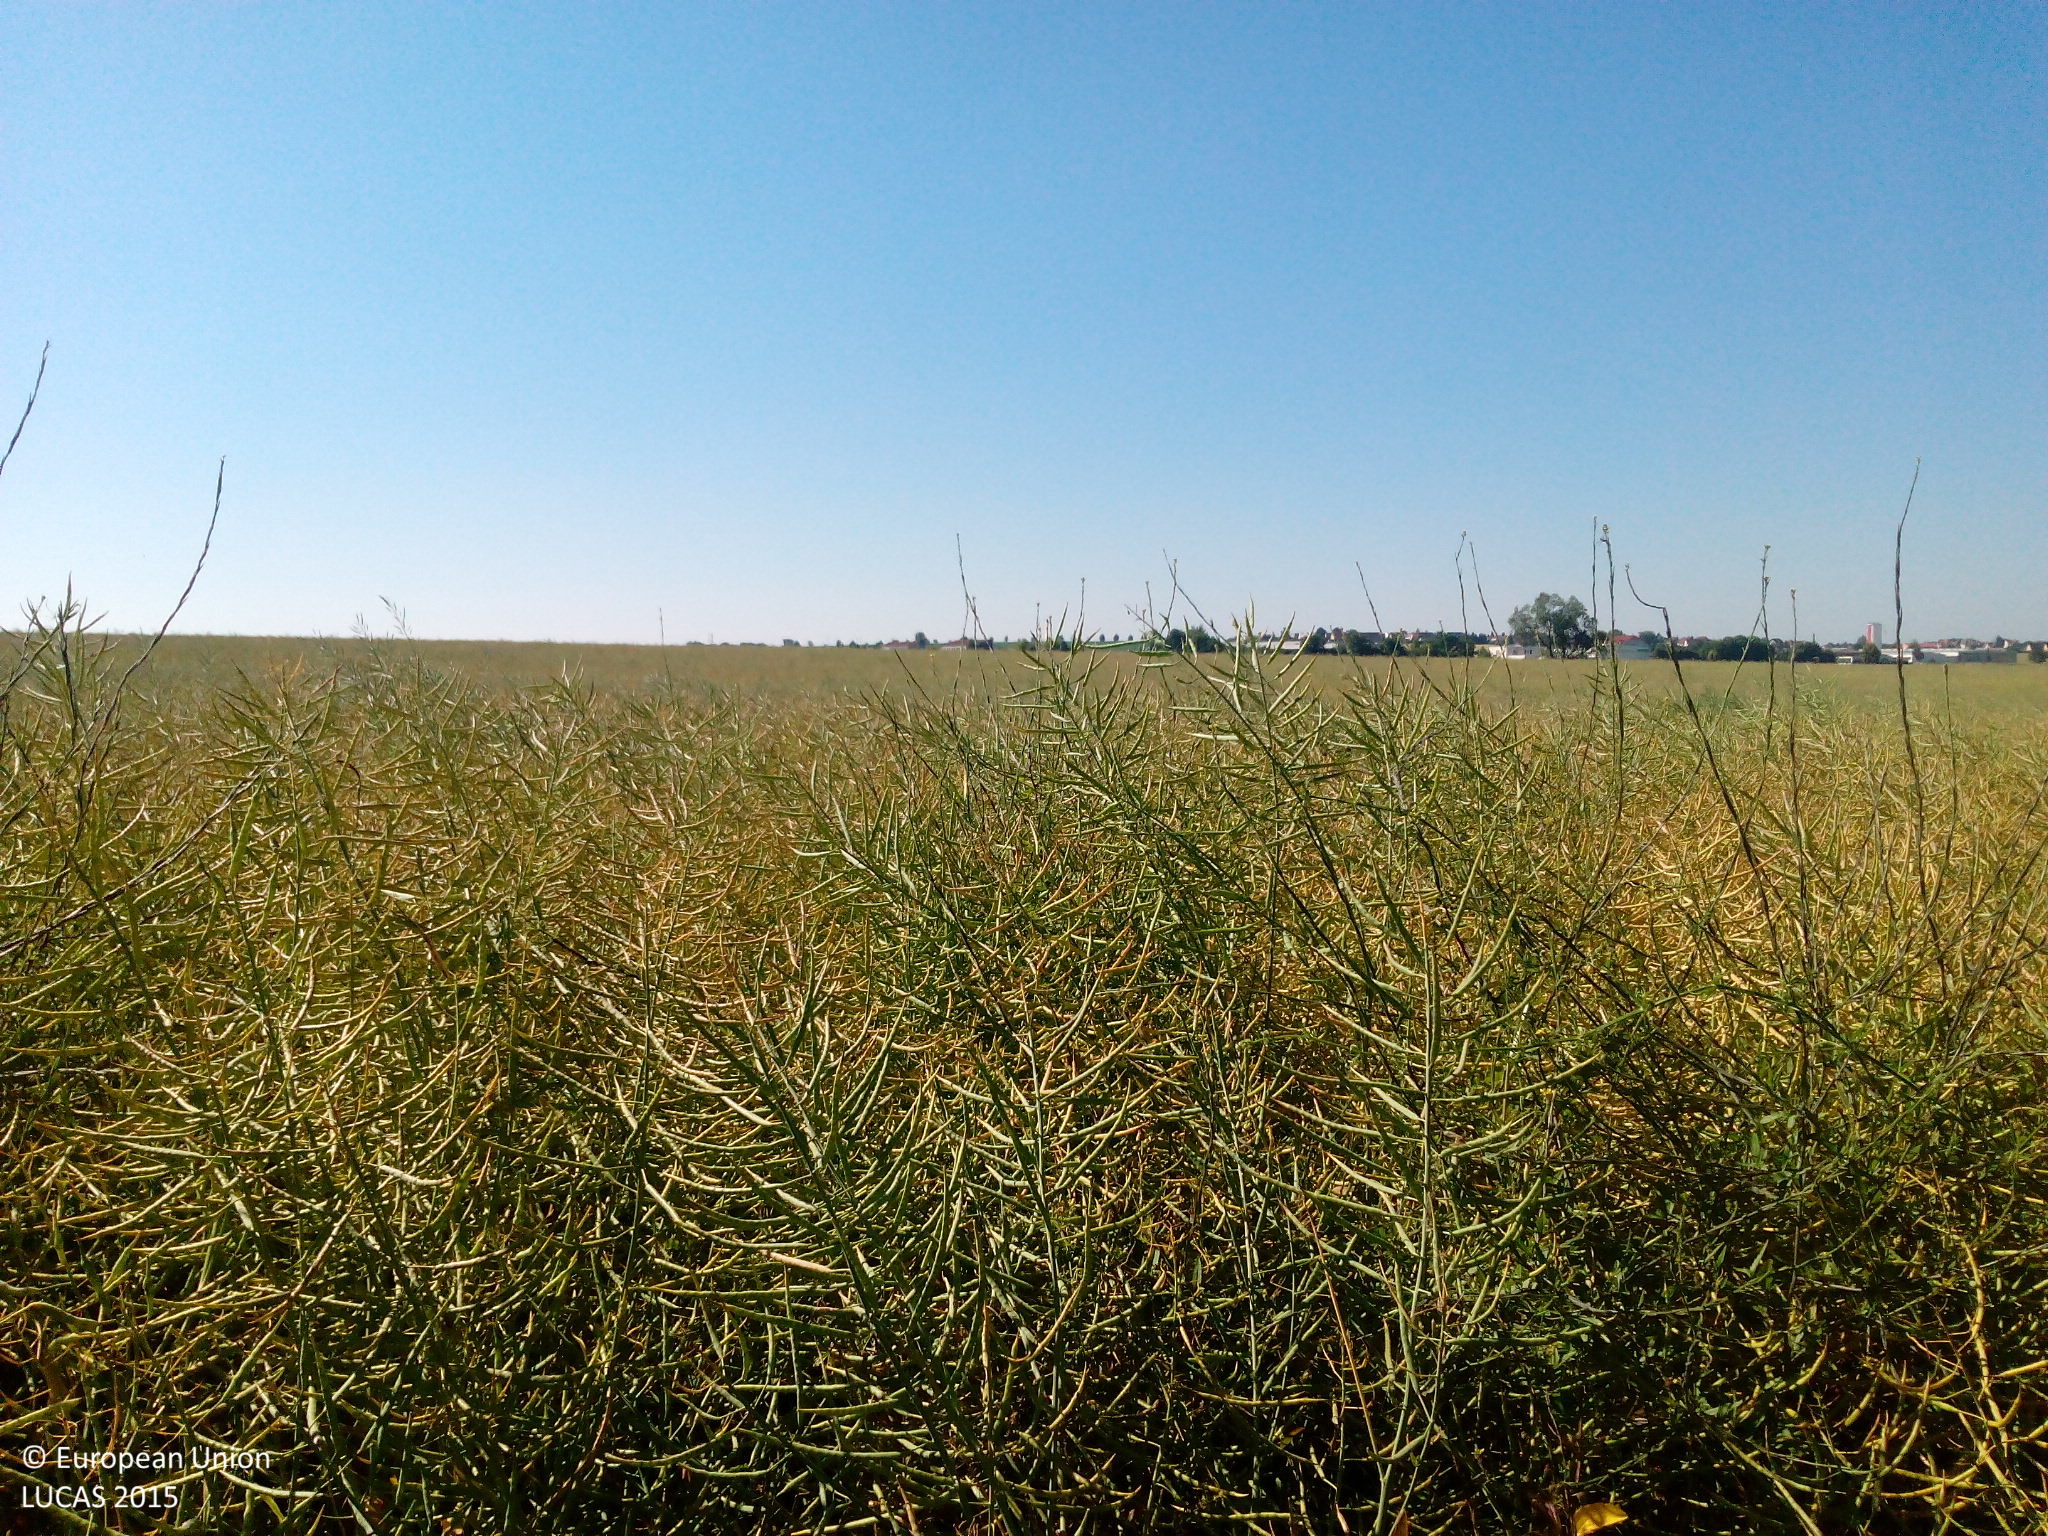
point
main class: Cropland
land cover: Rape and turnip rape
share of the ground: > 75 %
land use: Agriculture (excluding fallow land and kitchen gardens)
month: July
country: DE
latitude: 51.3293
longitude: 13.1144
